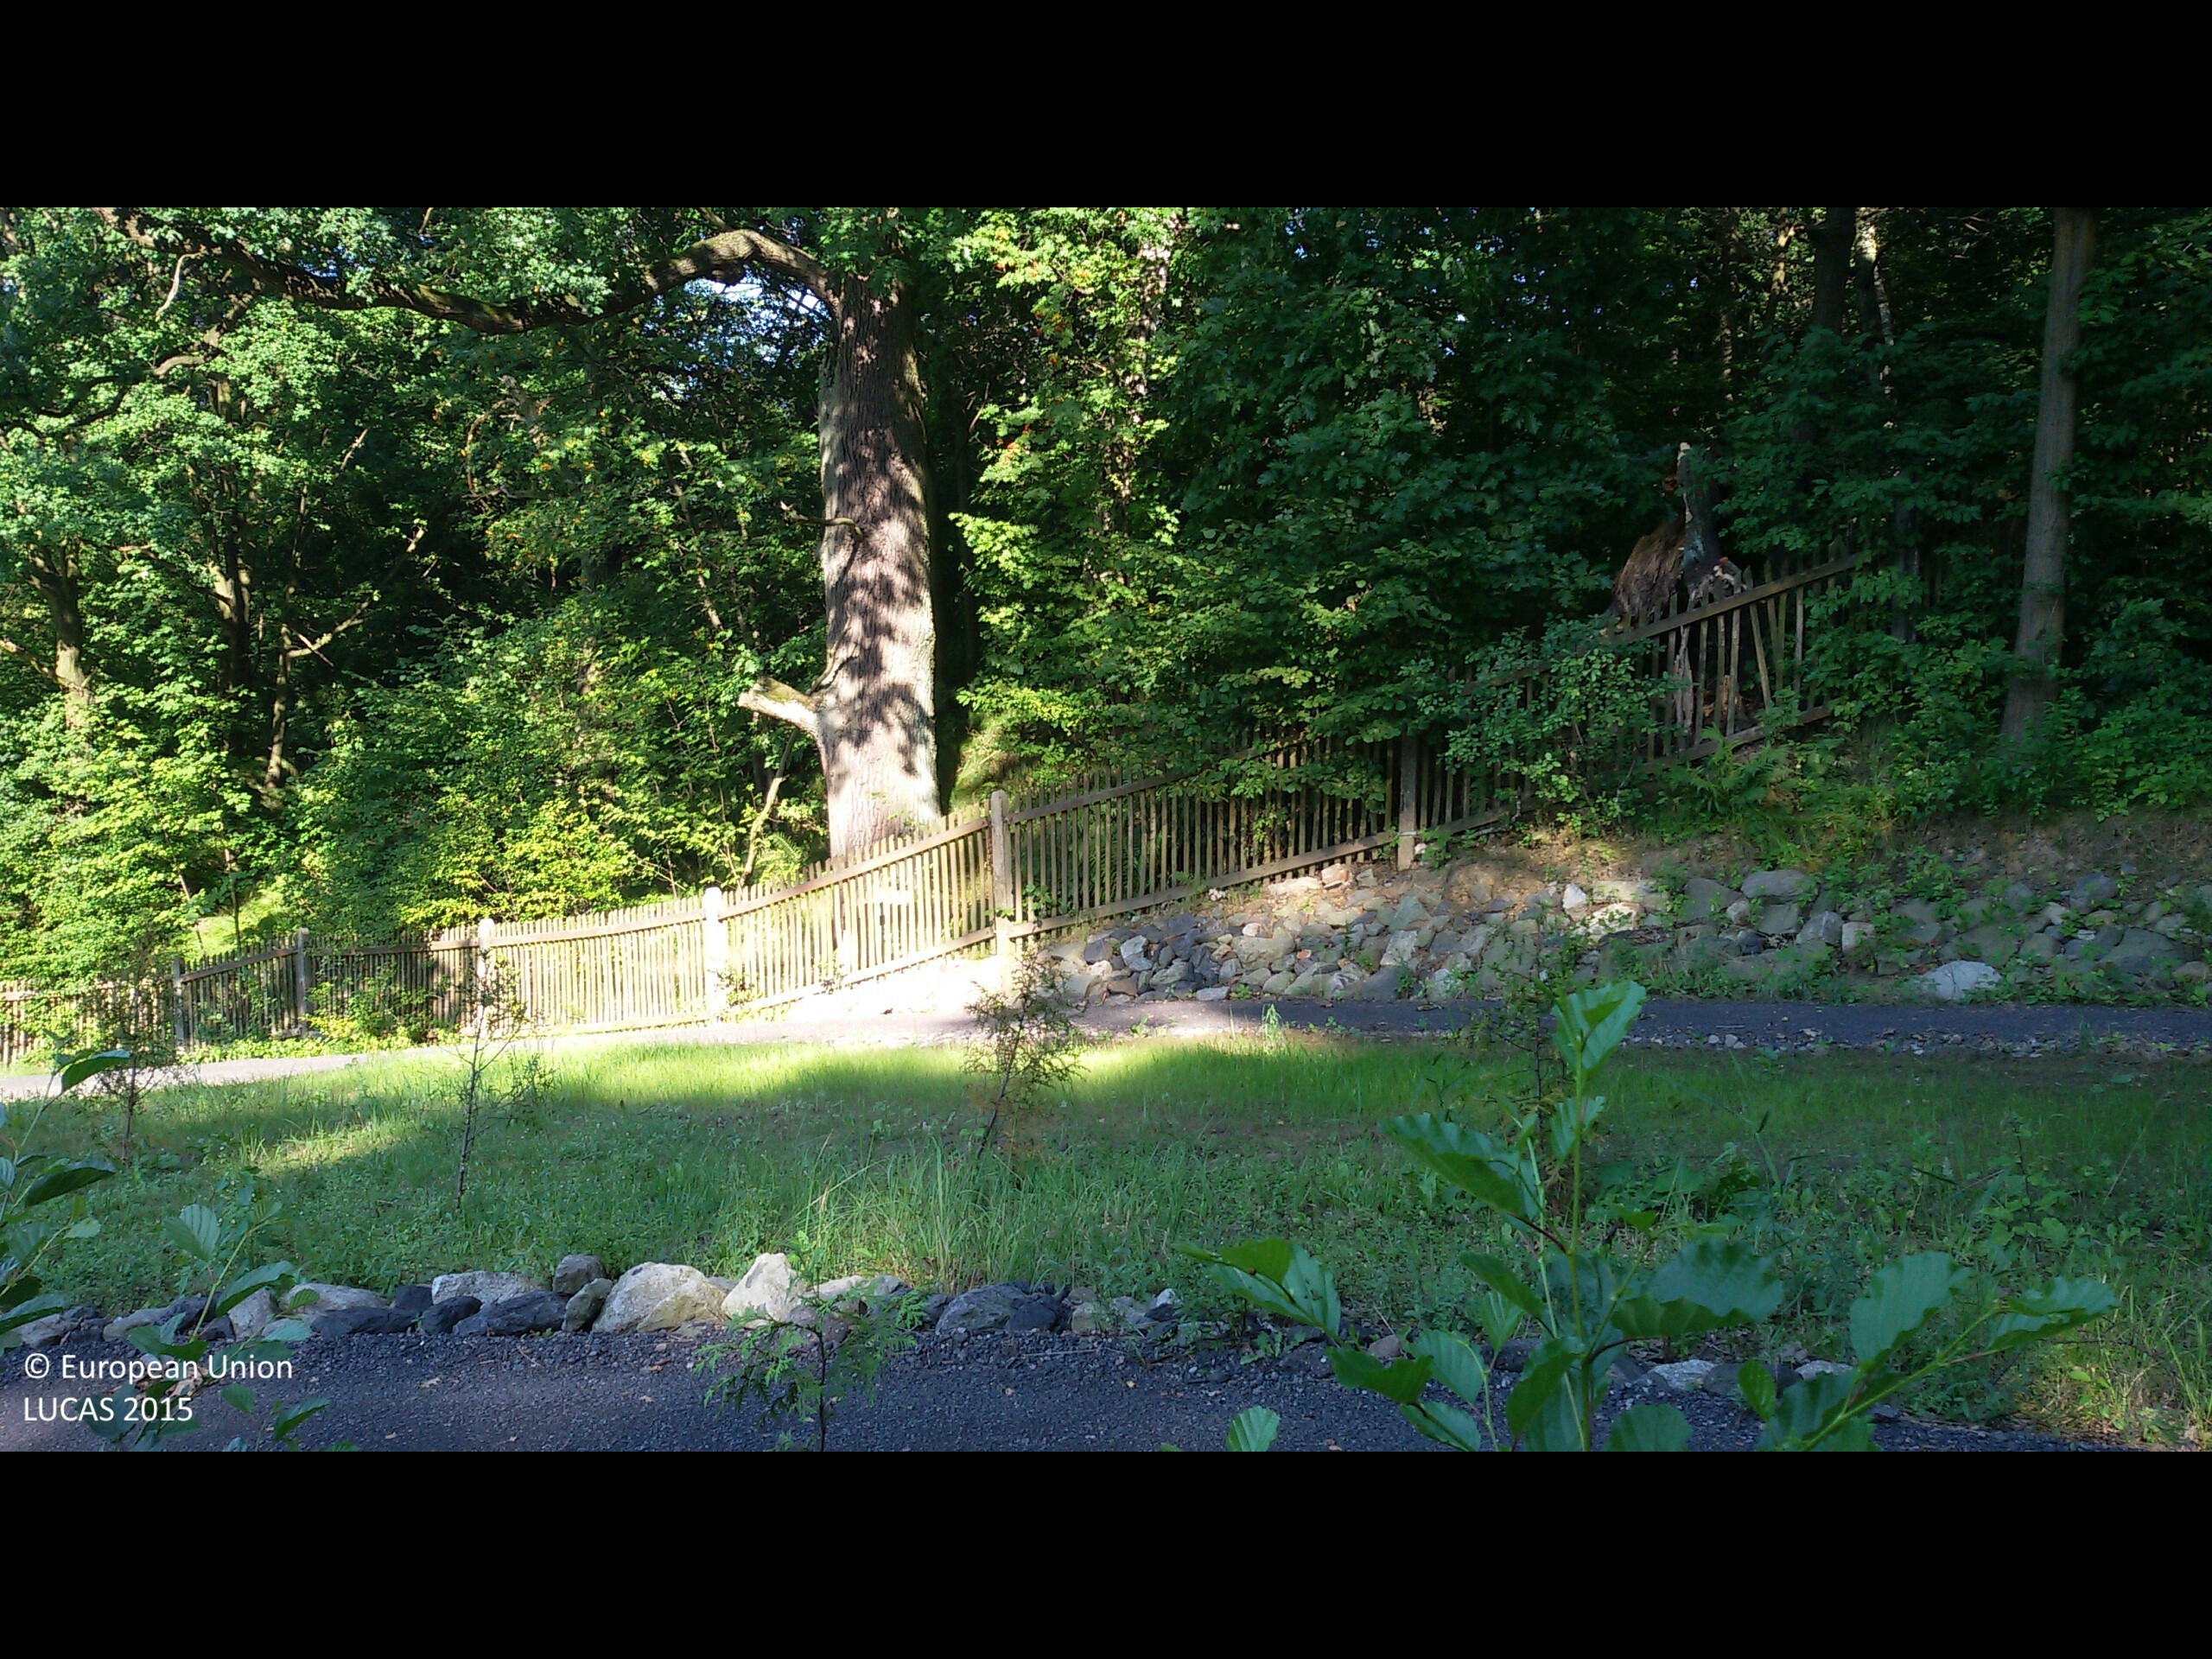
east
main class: Woodland
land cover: Other mixed woodland
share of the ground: 10 - 25 %
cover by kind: herbaceous plants 80 %, coniferous forest trees 10 %, broadleaved forest trees 10 %
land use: Amenities, museums, leisure
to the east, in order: Other mixed woodland; Tracks; Grassland with sparse tree/shrub cover; Tracks; Fences; Broadleaved woodland; Shruby margins; Ditches and canals; Other structural elements; Shrubland with sparse tree cover; Other structural elements; Spontaneously vegetated surfaces; Other structural elements; Broadleaved woodland; Tracks; Broadleaved woodland; Tracks; Broadleaved woodland; Artificial constructions in urban areas
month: July
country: PL
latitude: 49.9521
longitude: 18.5629
